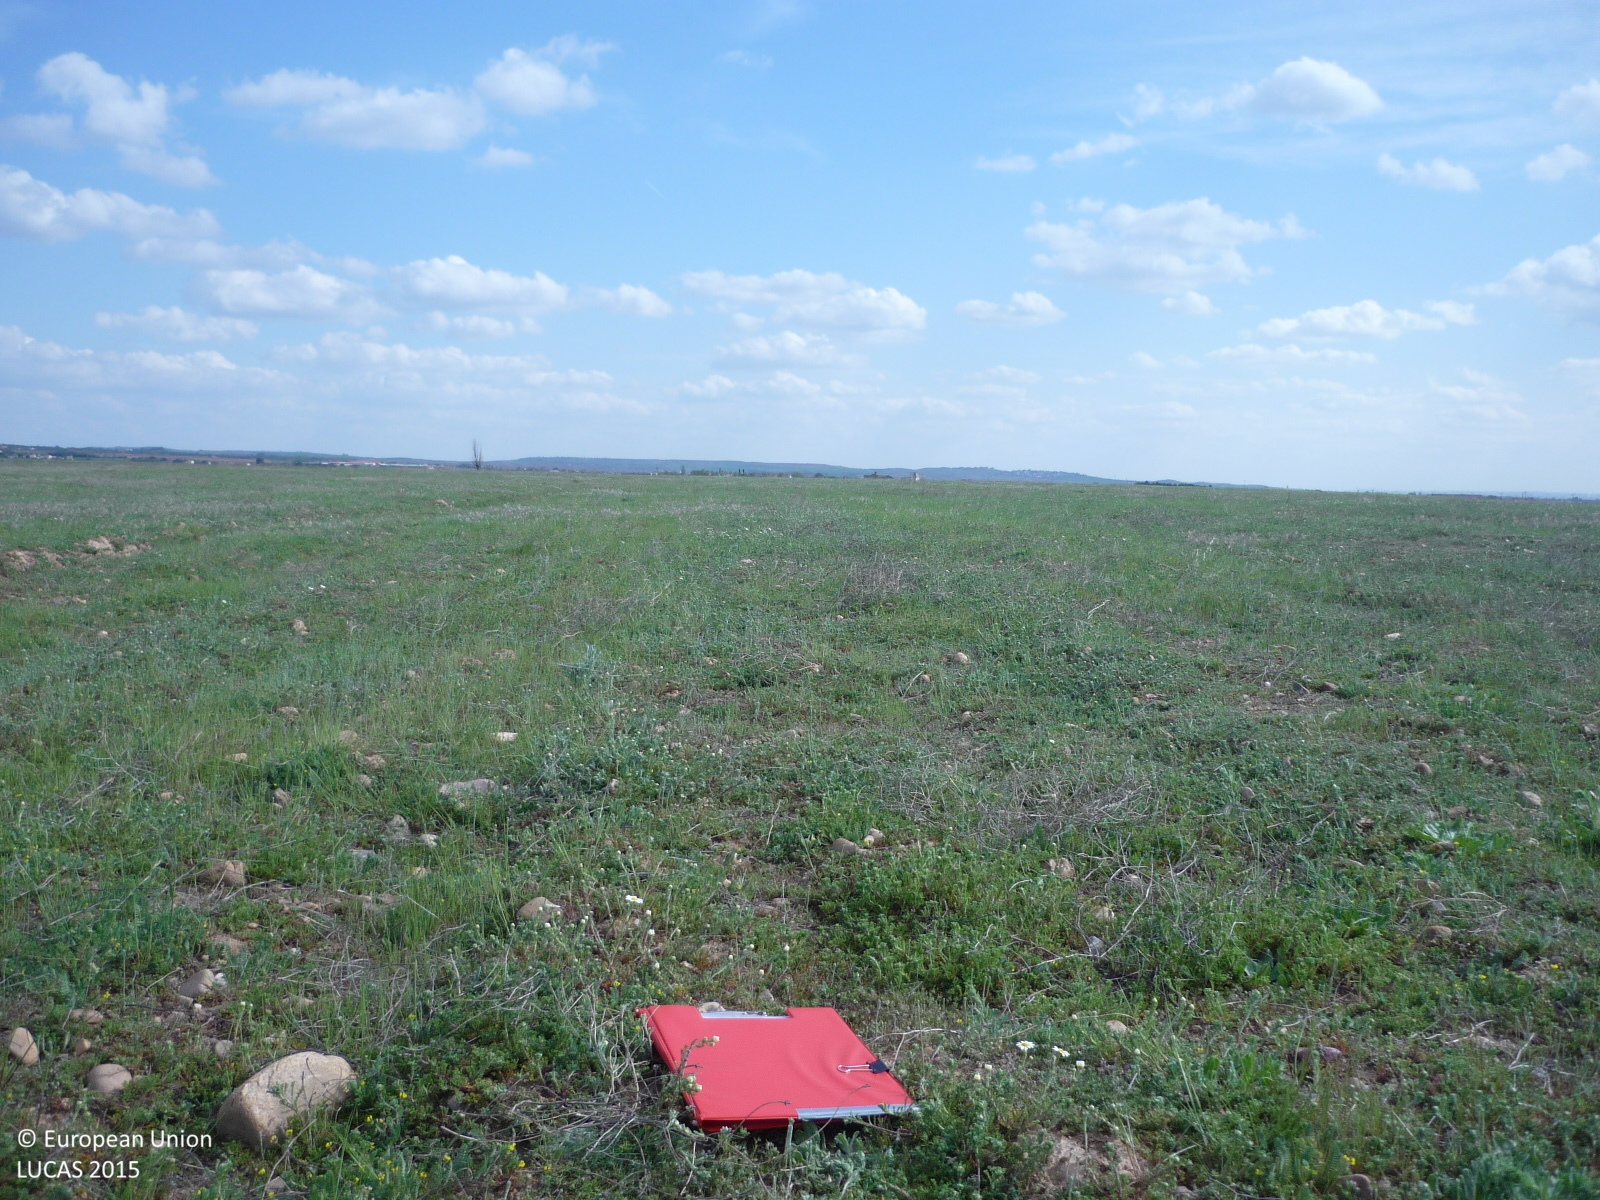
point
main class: Grassland
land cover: Spontaneously vegetated surfaces
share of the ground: > 75 %
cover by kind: herbaceous plants 95 %, consolidated bare surface 5 %
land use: Fallow land
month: April
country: ES
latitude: 40.7034
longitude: -3.4955
